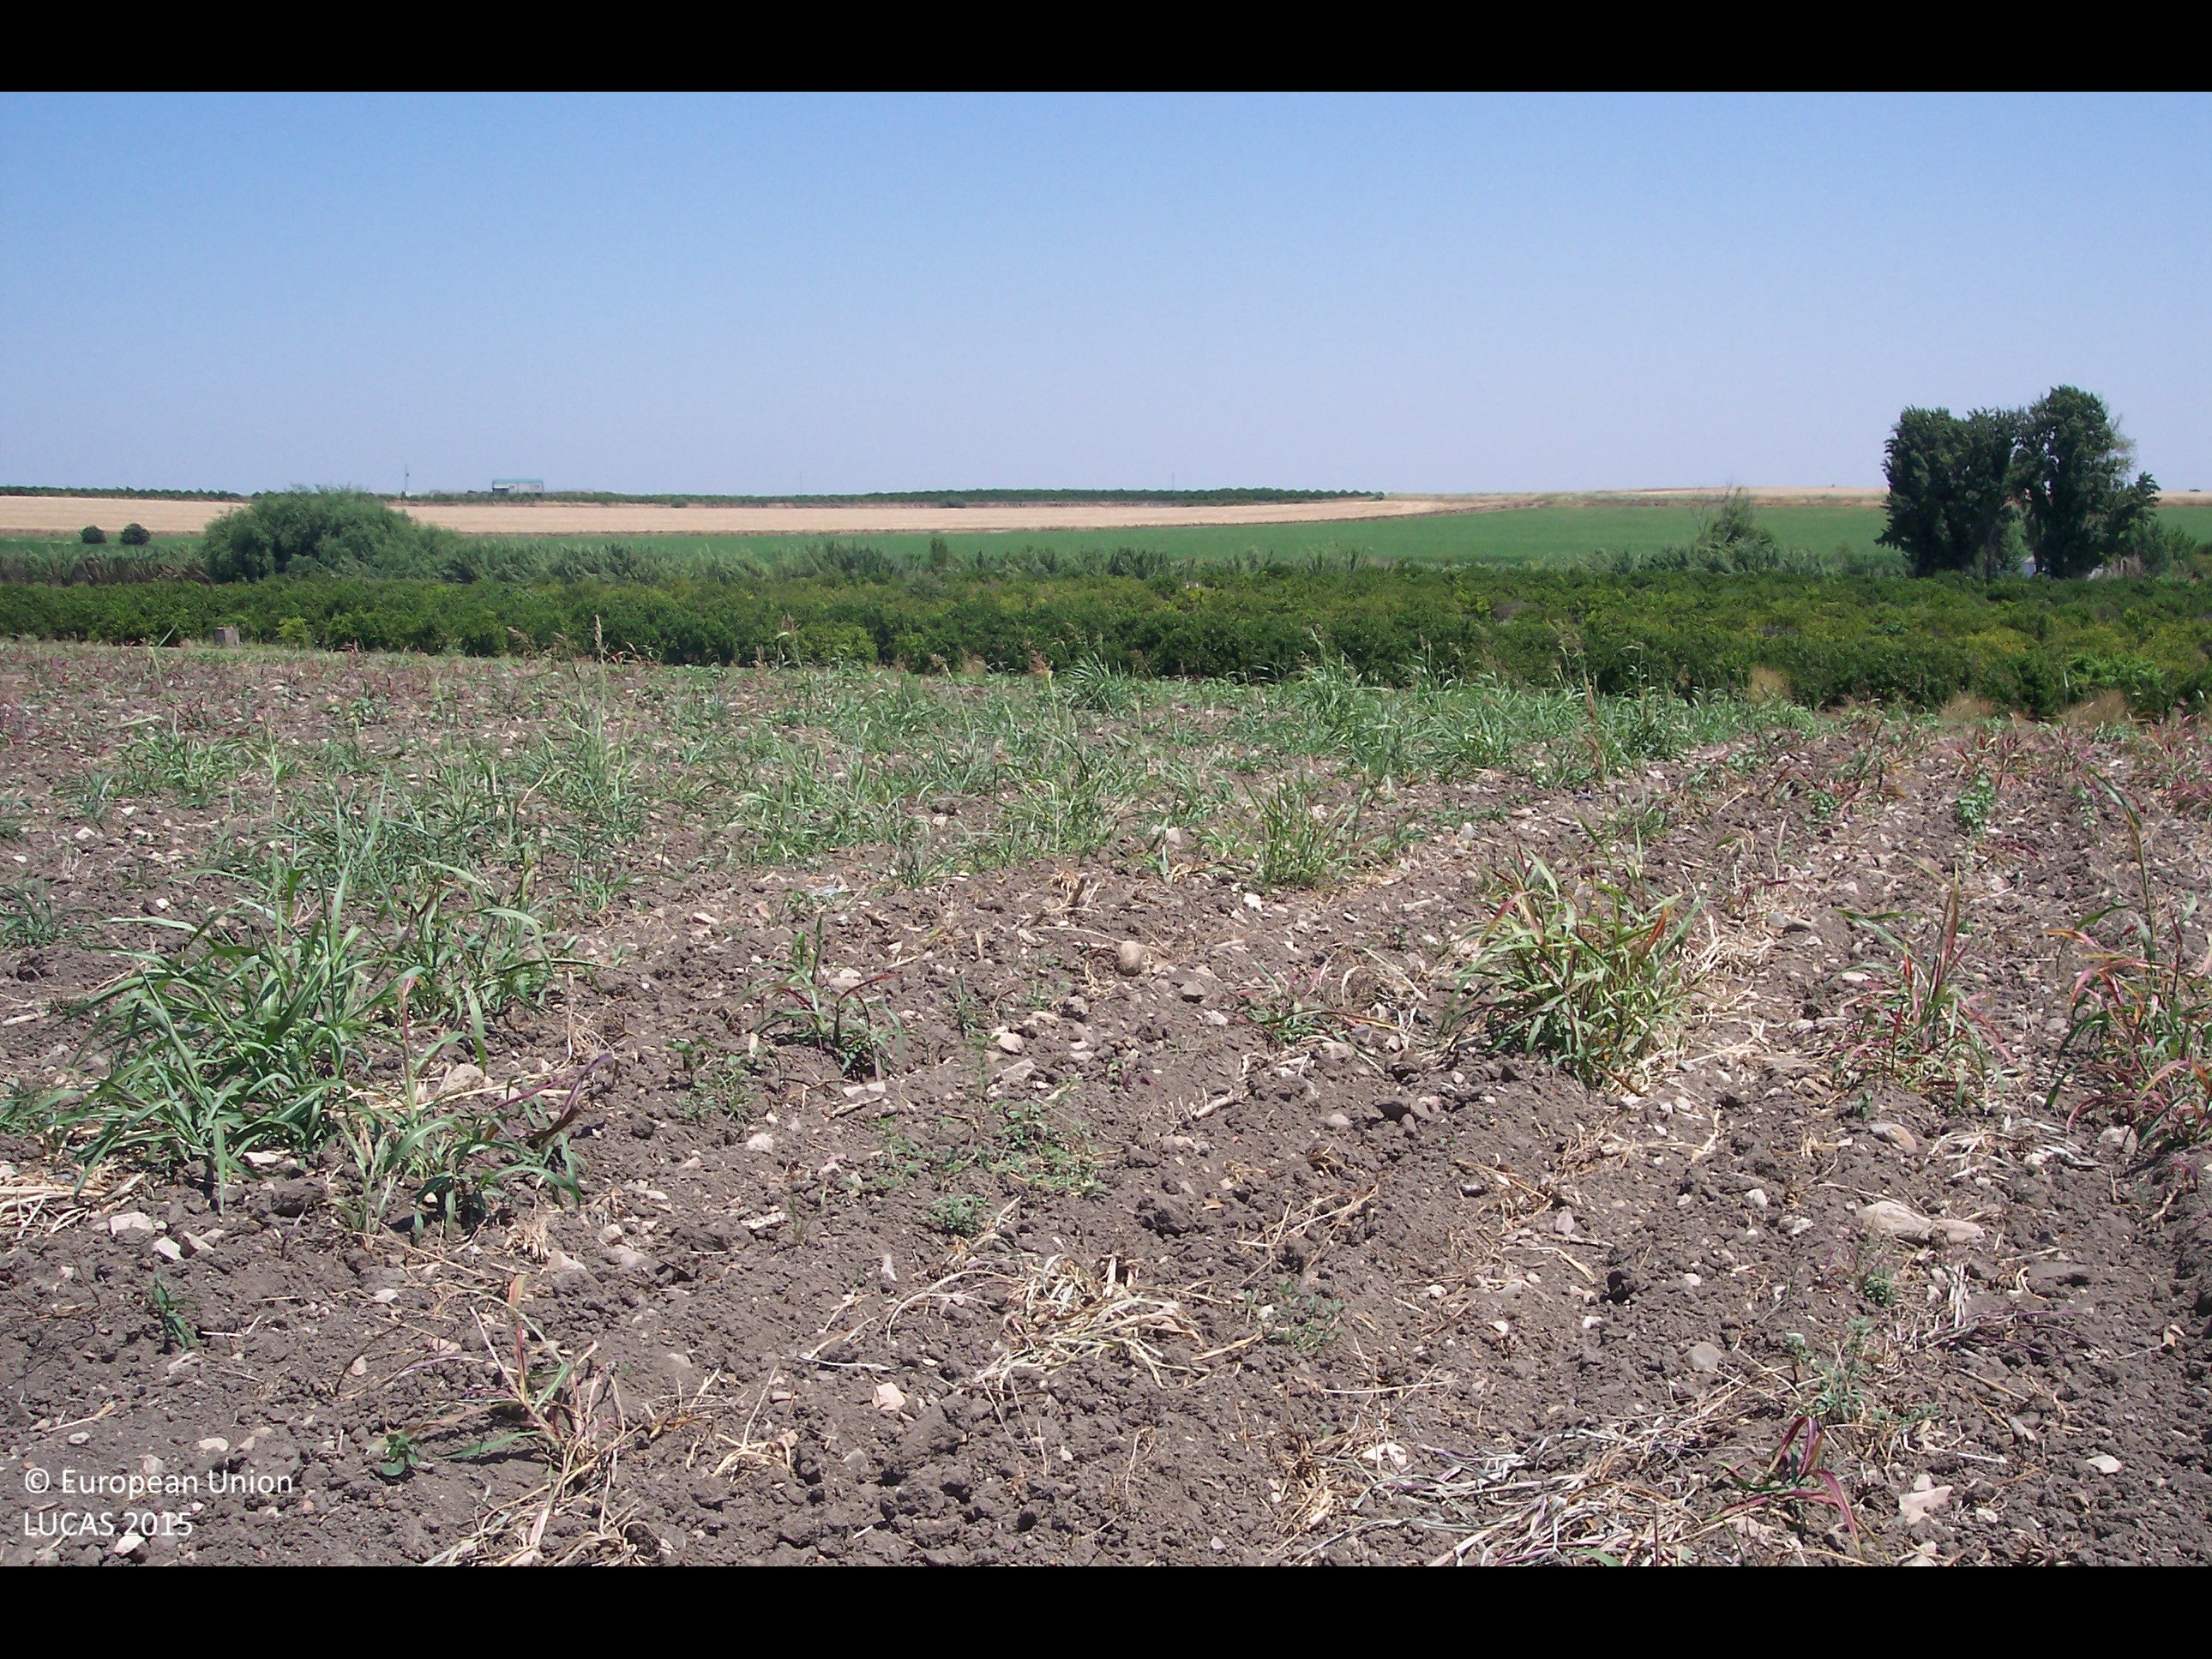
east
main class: Cropland
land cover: Cotton
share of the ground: < 10 %
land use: Agriculture (excluding fallow land and kitchen gardens)
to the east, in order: Cotton; Tracks; Oranges
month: May
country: ES
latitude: 37.5529
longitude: -5.9527
